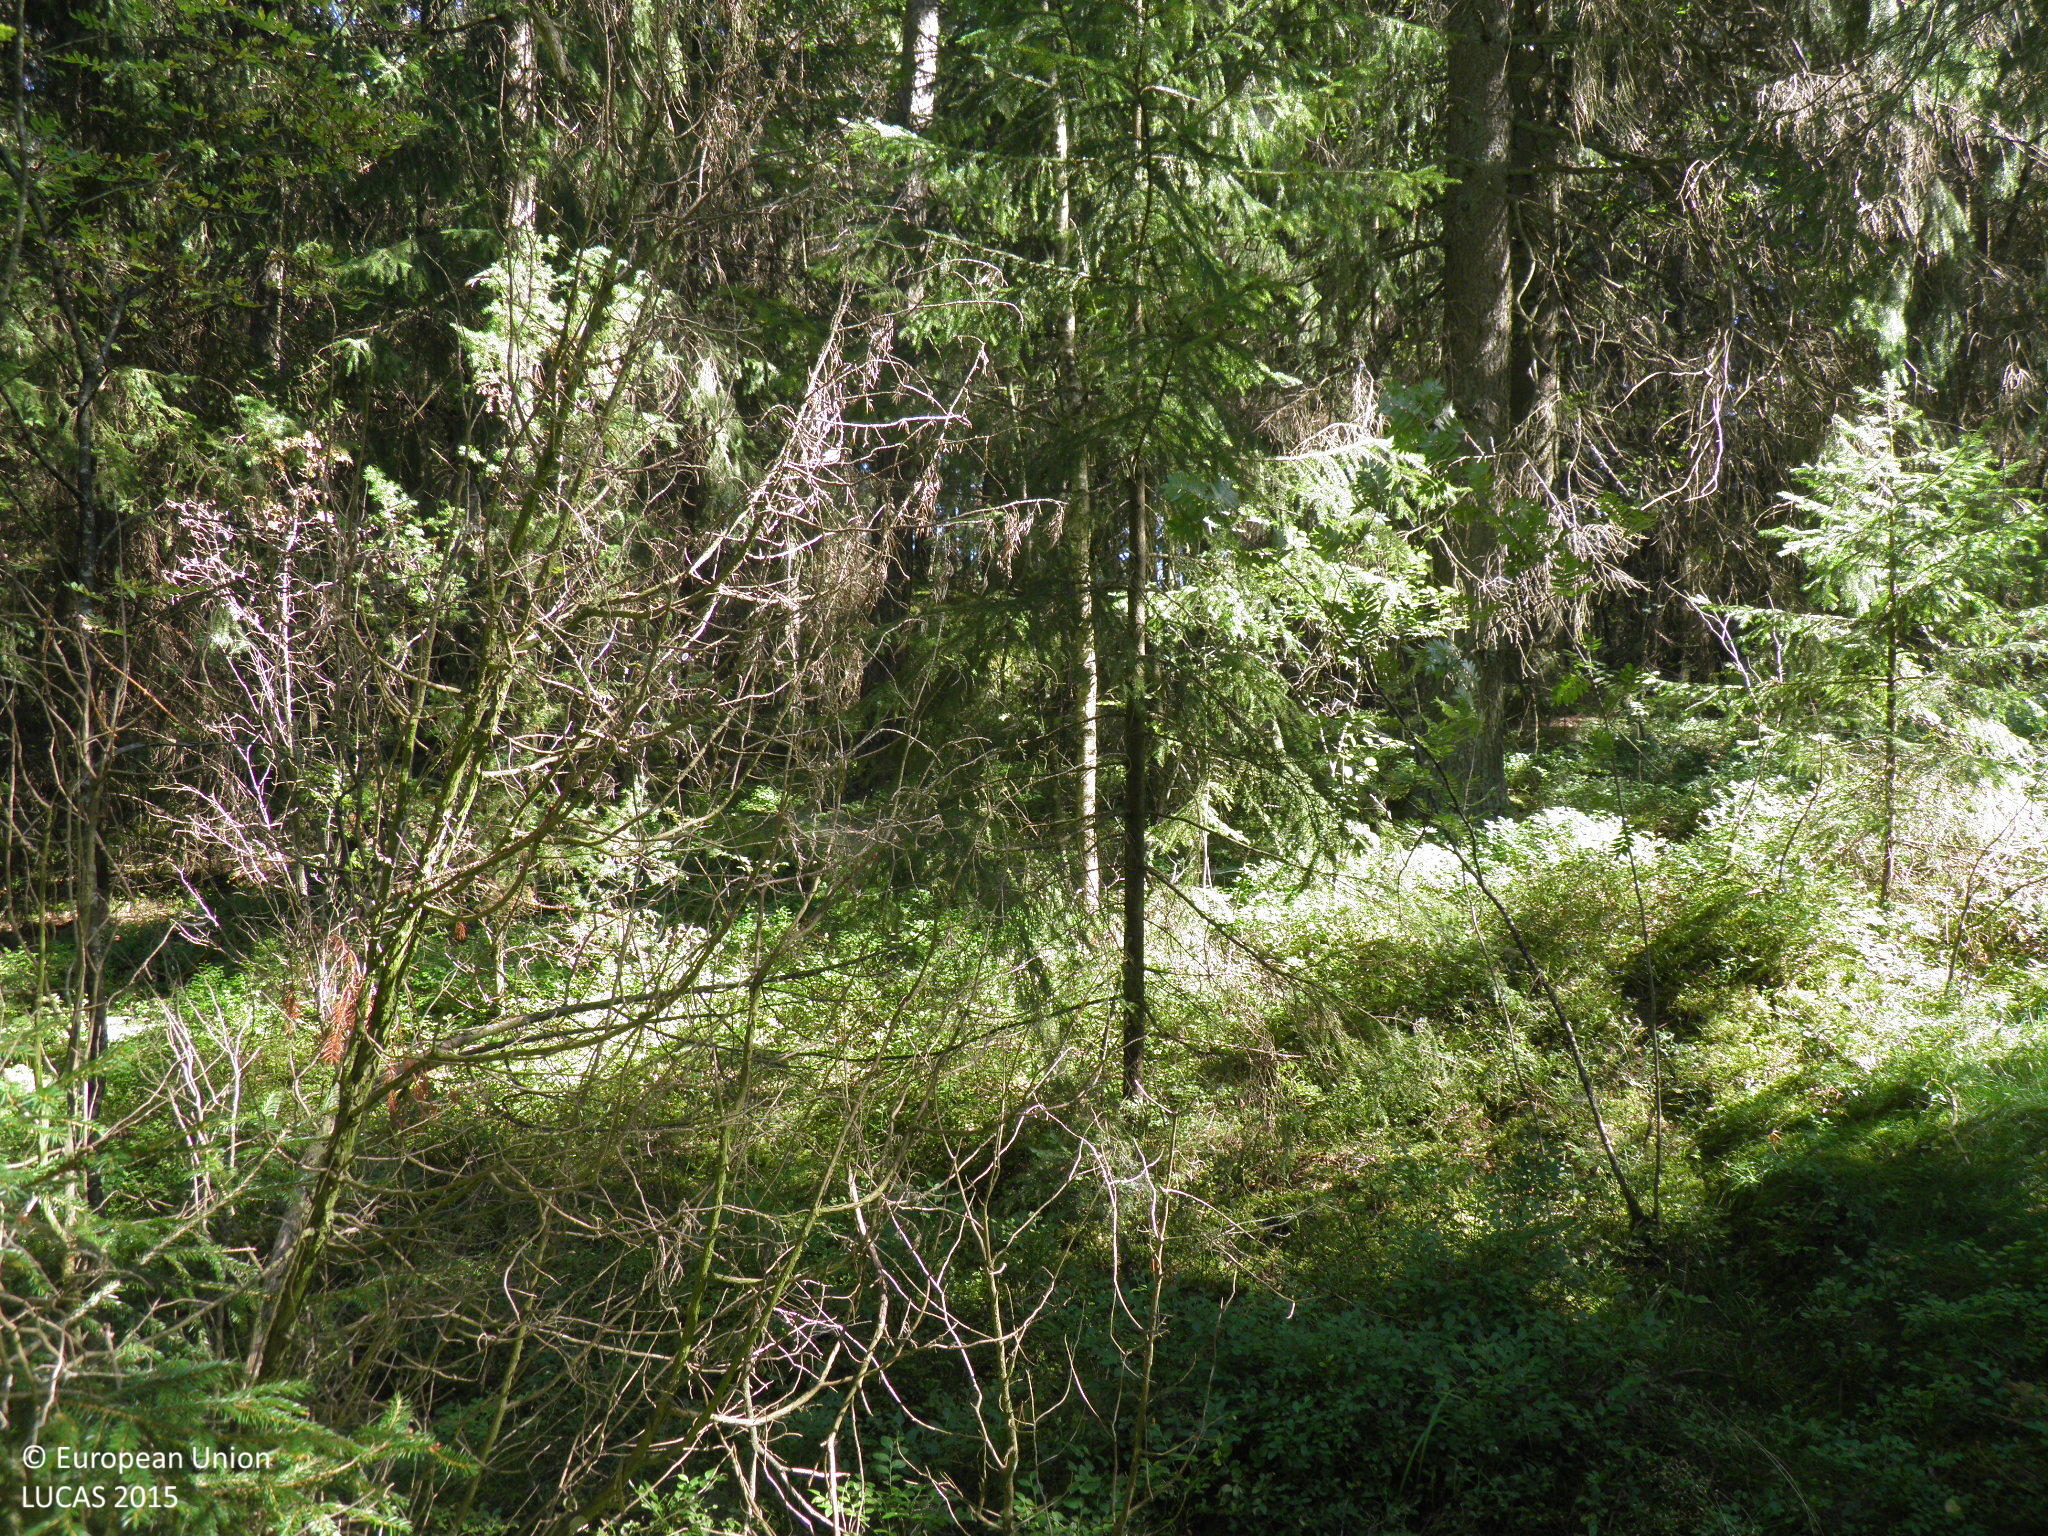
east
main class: Woodland
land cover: Spruce dominated coniferous woodland
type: hemiboreal forest and nemoral coniferous forest and mixed broadleaved-coniferous forest
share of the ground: 50 - 75 %
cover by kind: coniferous forest trees 50 %, shrubs 20 %, broadleaved forest trees 10 %, herbaceous plants 10 %, lichens and mosses 10 %
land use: Forestry
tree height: > 5 m
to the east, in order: Spruce dominated coniferous woodland; Temporary grasslands; Broadleaved woodland; Inland fresh running water
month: August
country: FI
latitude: 60.7161
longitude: 21.8815
